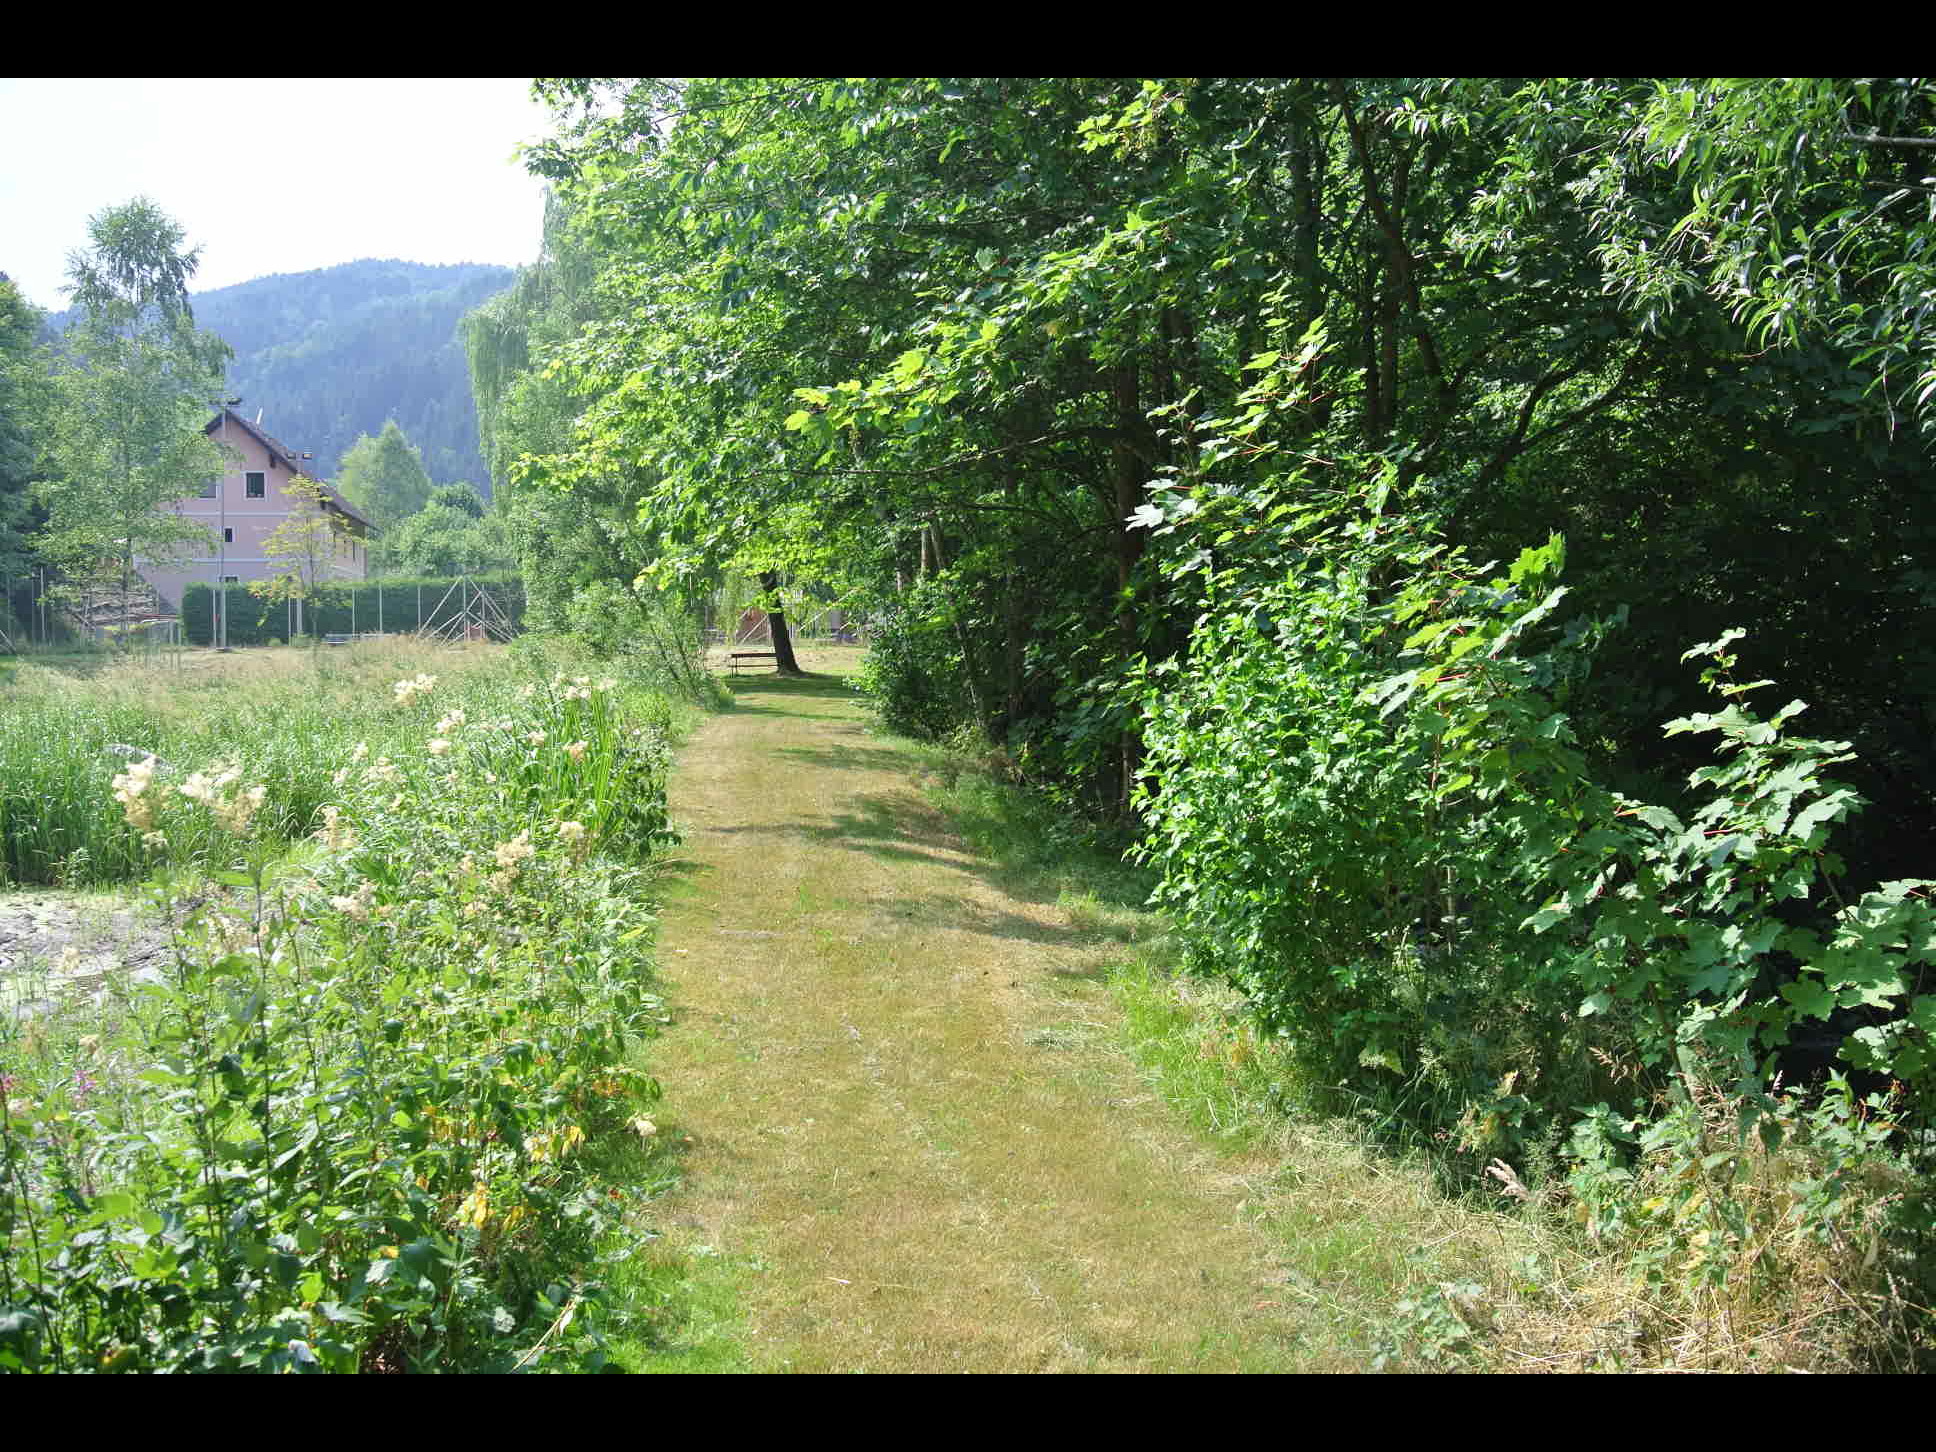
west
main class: Grassland
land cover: Grassland with sparse tree/shrub cover
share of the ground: > 75 %
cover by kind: herbaceous plants 90 %, broadleaved forest trees 5 %, shrubs 5 %
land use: Amenities, museums, leisure
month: July
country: AT
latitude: 47.5522
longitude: 16.0487
